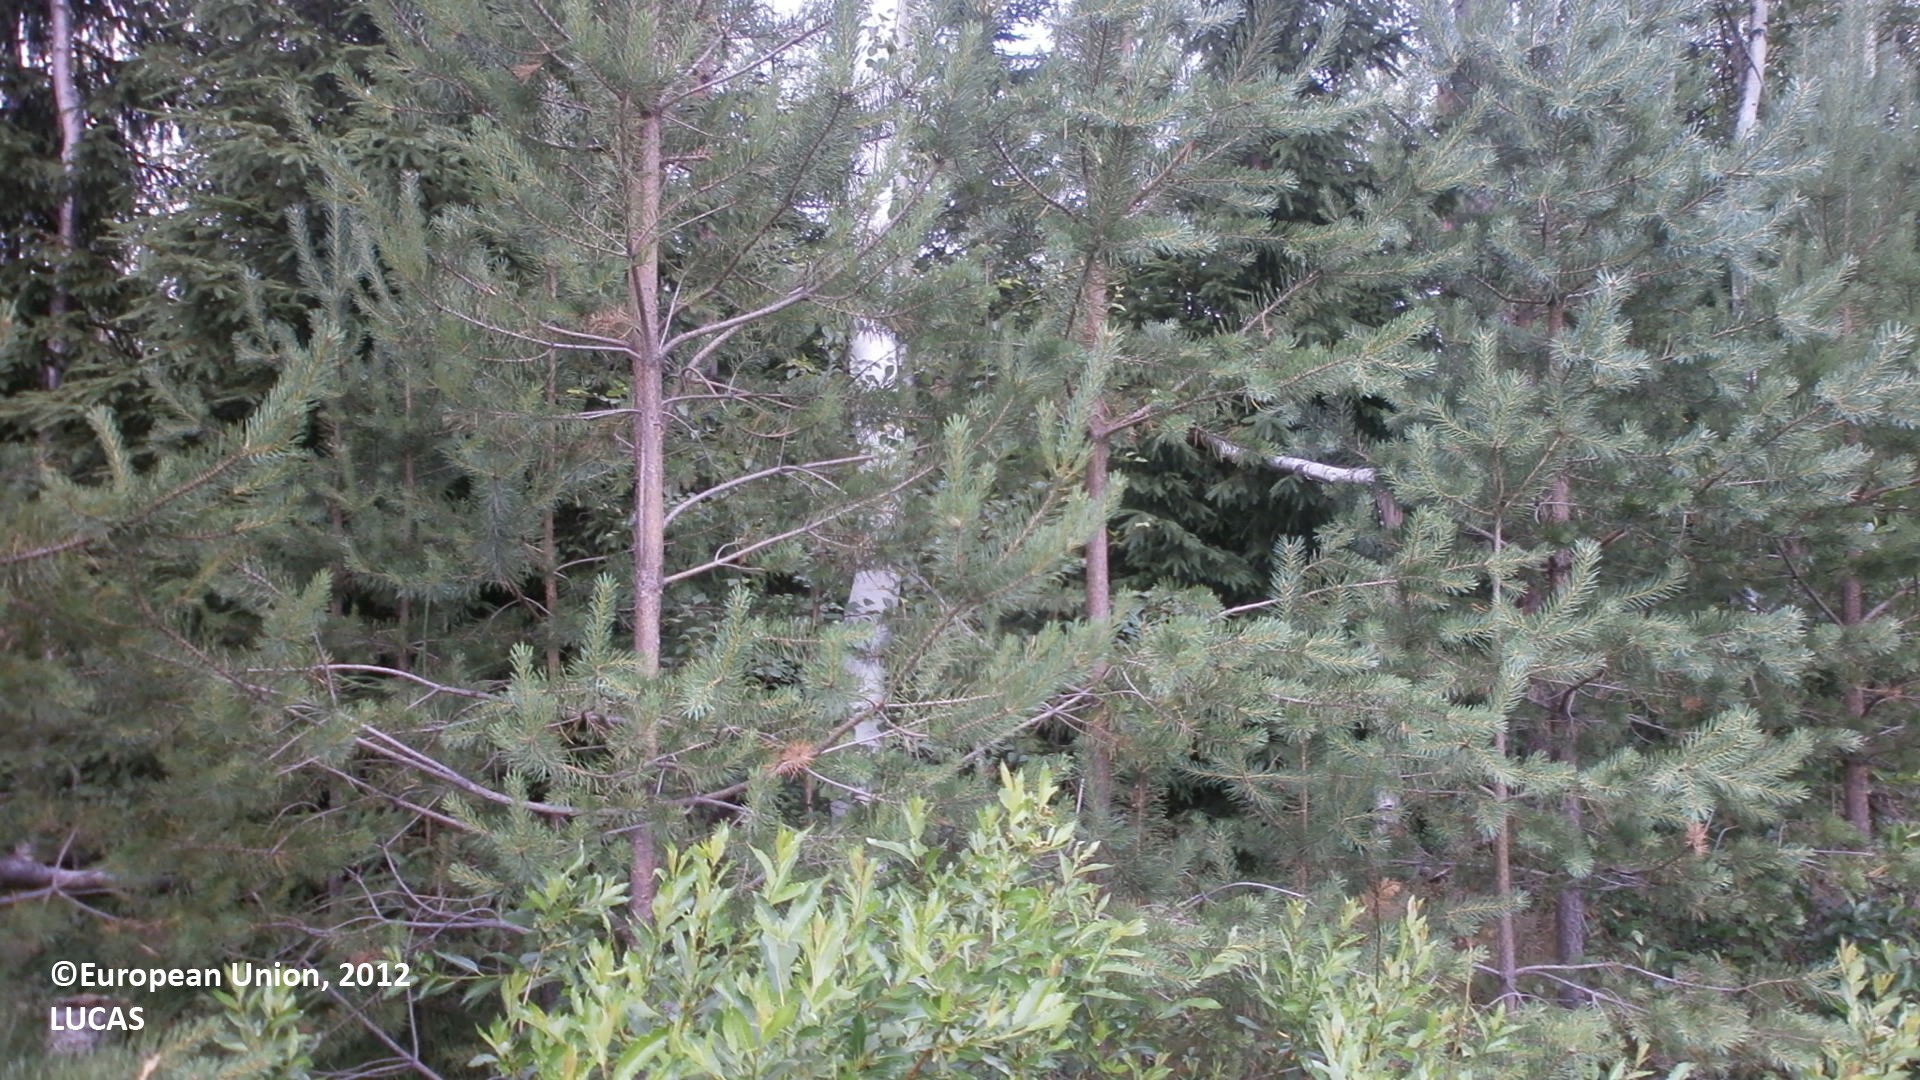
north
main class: Cropland
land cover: Oats
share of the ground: > 75 %
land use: Agriculture (excluding fallow land and kitchen gardens)
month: July
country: FI
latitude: 64.2422
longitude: 24.1101
